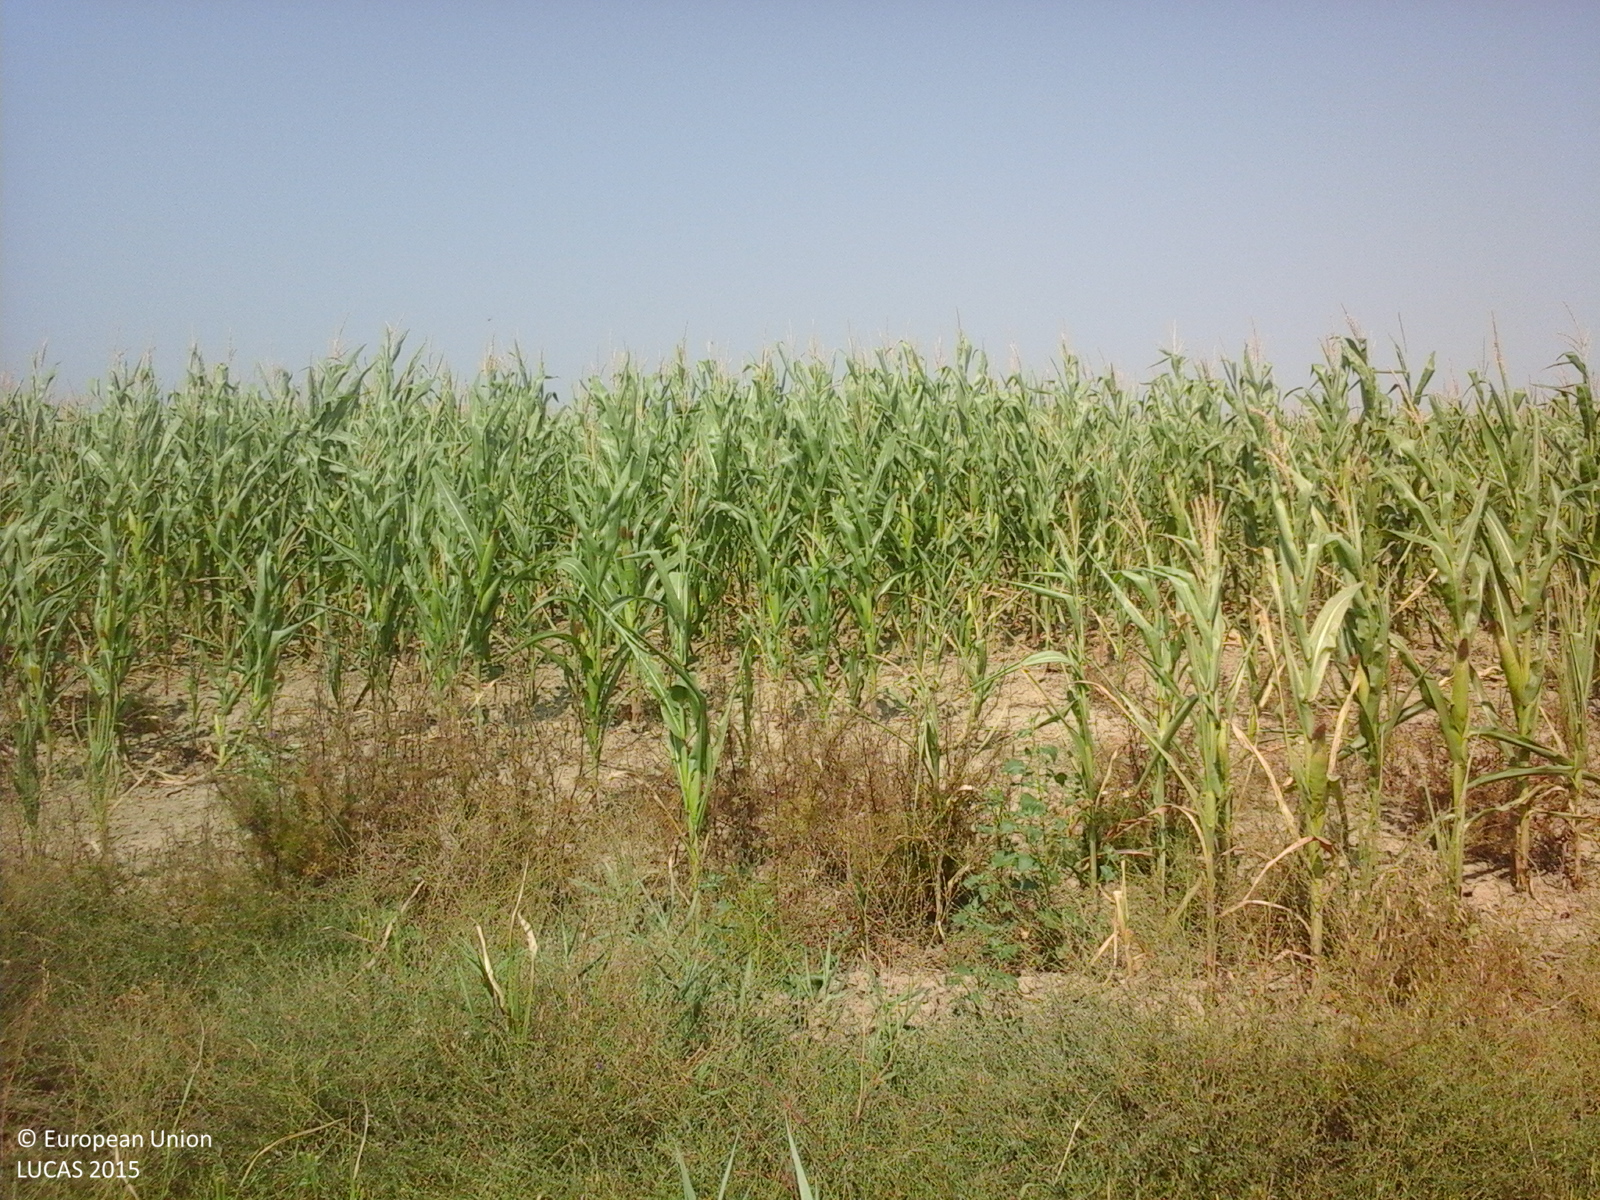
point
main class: Cropland
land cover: Maize
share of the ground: > 75 %
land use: Agriculture (excluding fallow land and kitchen gardens)
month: July
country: RO
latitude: 45.4341
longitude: 27.7890
